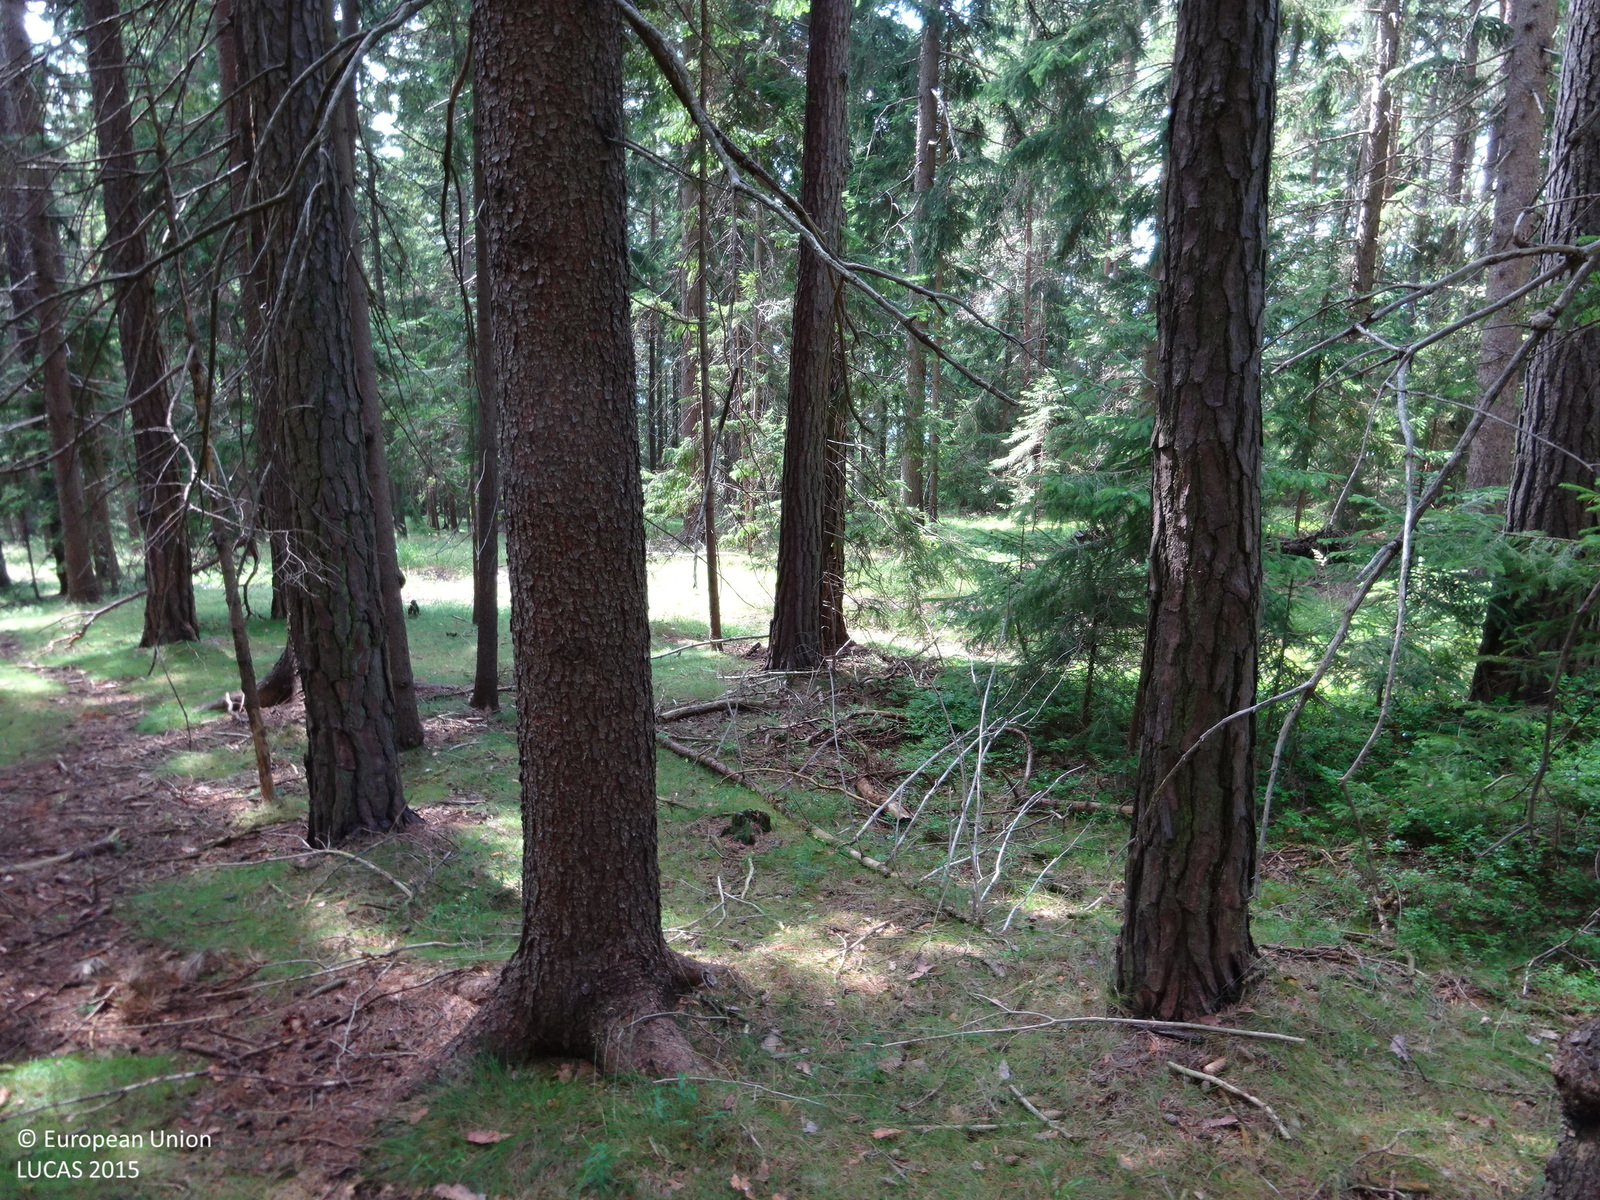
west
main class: Woodland
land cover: Spruce dominated coniferous woodland
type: alpine coniferous forest
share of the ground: > 75 %
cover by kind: coniferous forest trees 80 %, shrubs 10 %, herbaceous plants 10 %
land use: Forestry
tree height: > 5 m
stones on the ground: < 10 %
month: July
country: AT
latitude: 47.2240
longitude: 15.4280
